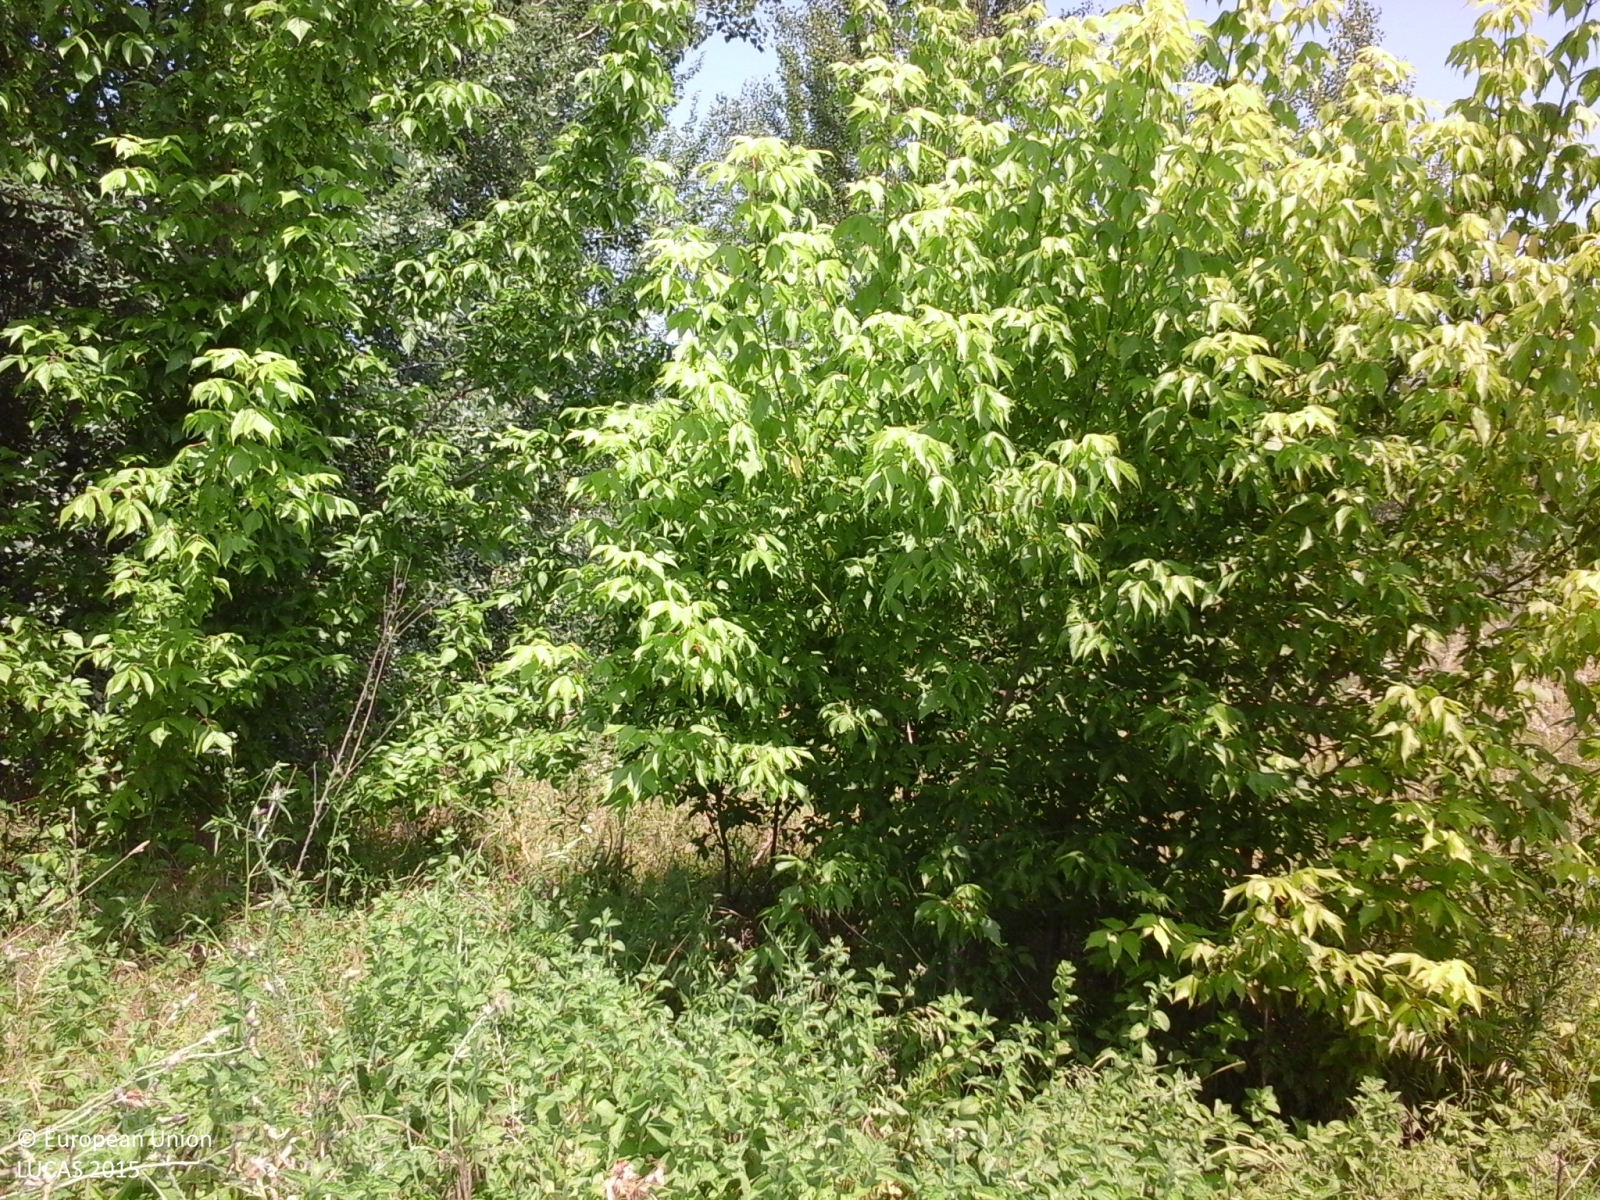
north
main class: Shrubland
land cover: Shrubland with sparse tree cover
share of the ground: > 75 %
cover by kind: shrubs 60 %, herbaceous plants 35 %, broadleaved forest trees 5 %
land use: Semi-natural and natural areas not in use
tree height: < 5 m
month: June
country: IT
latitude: 44.5962
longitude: 11.1942
